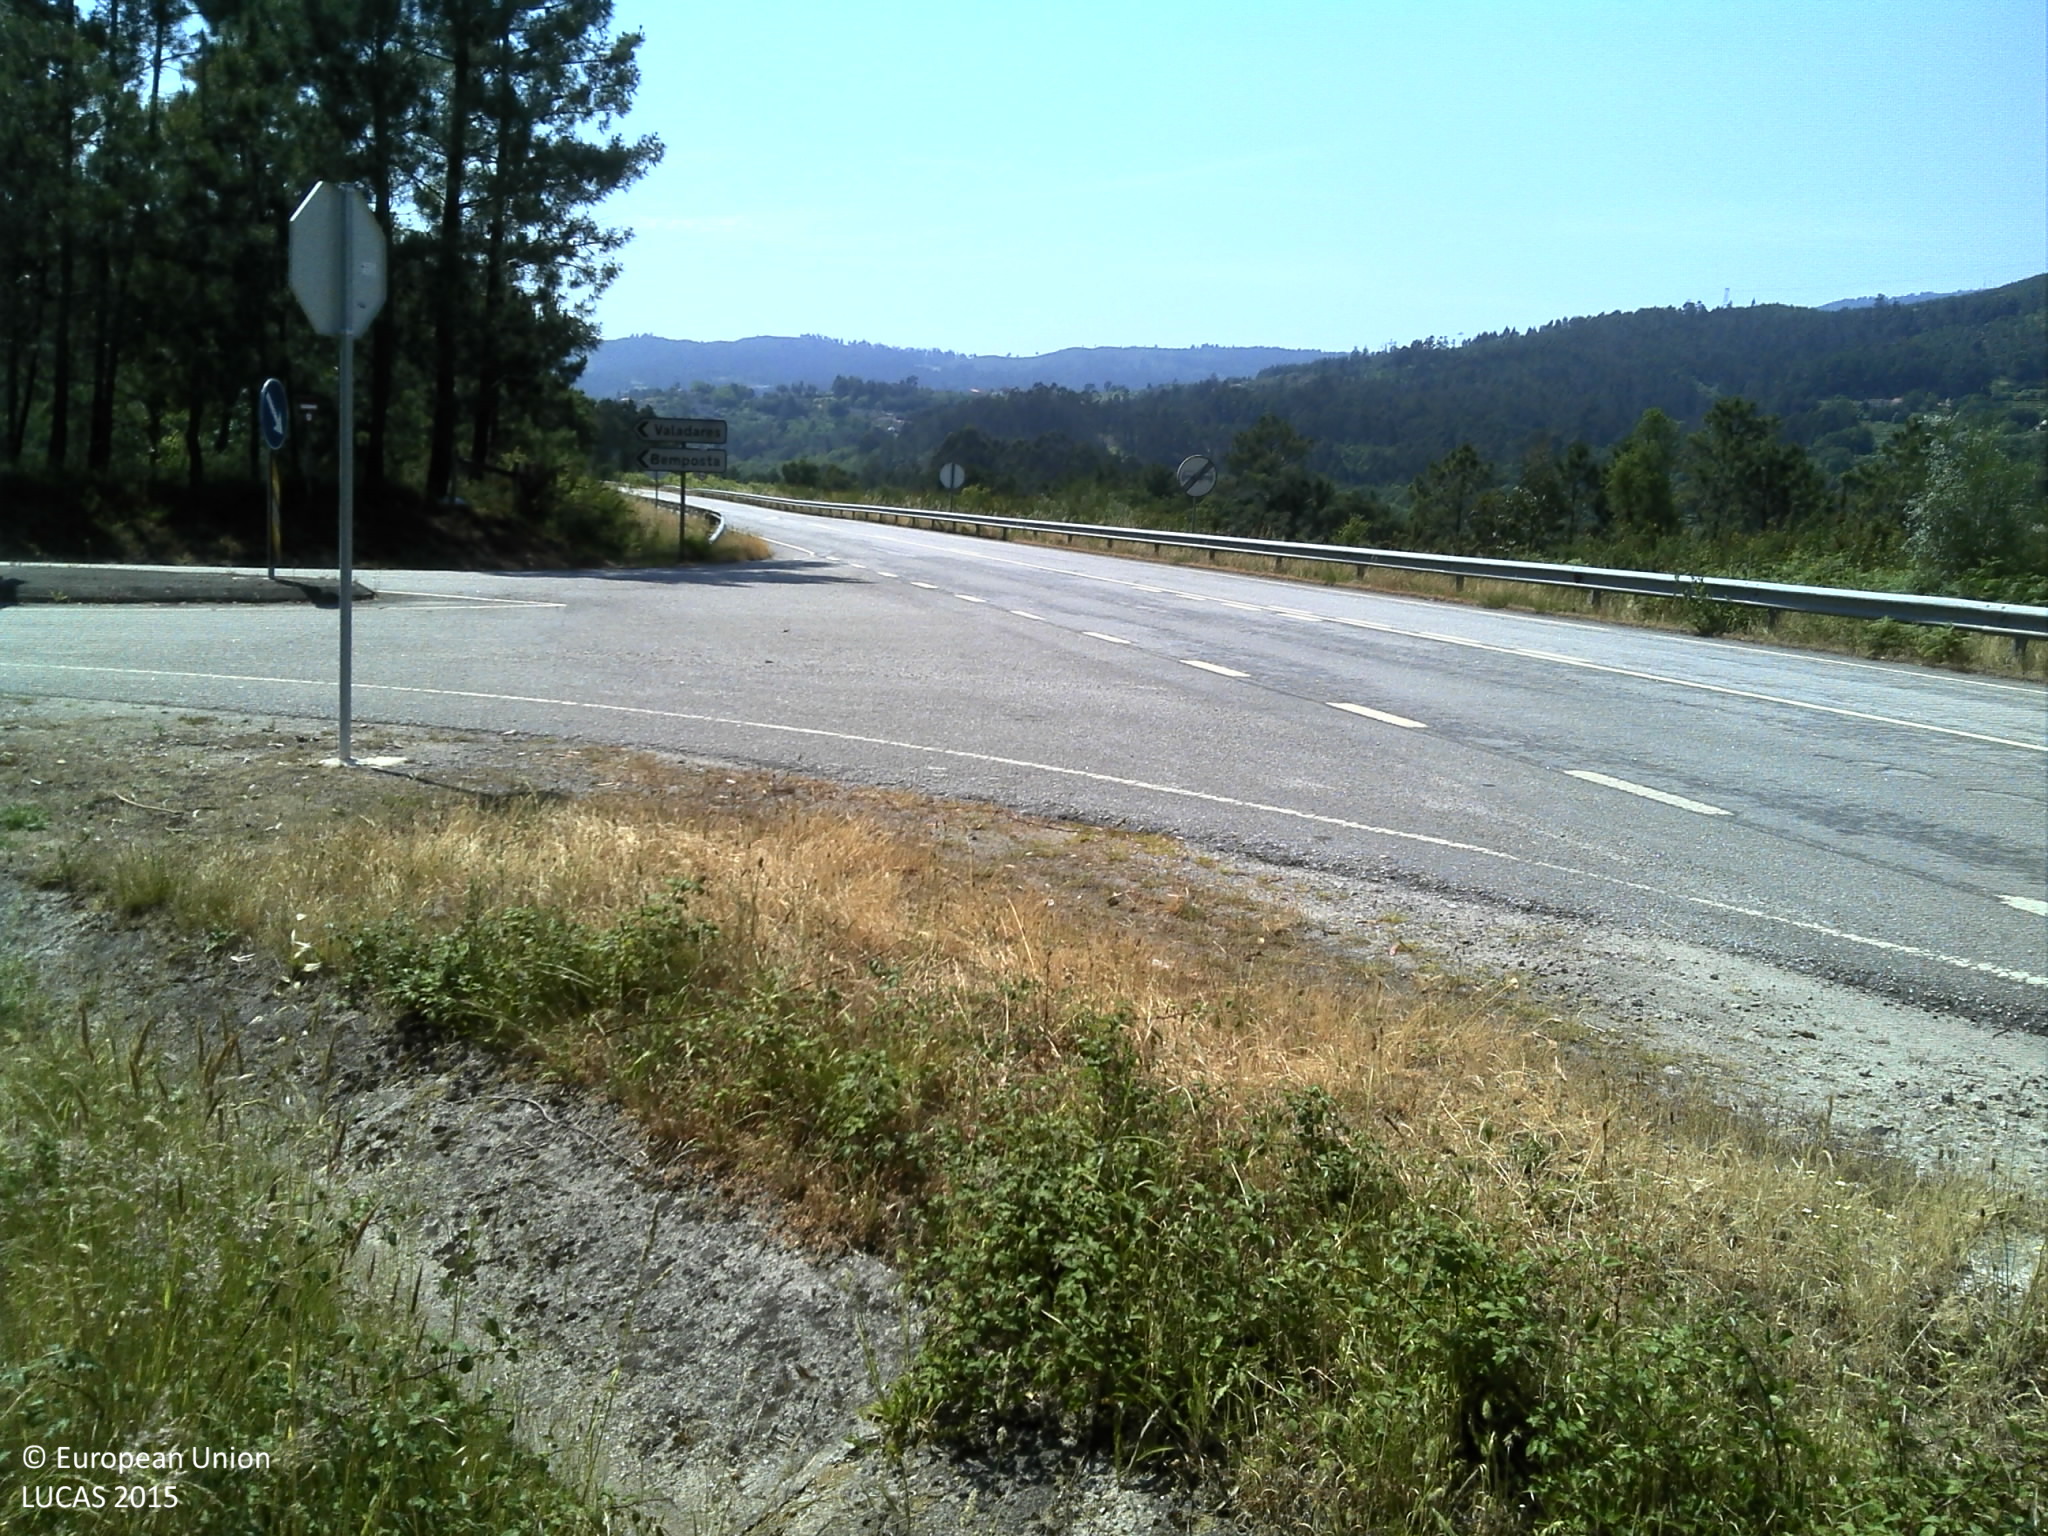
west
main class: Shrubland
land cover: Shrubland with sparse tree cover
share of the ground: > 75 %
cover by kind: shrubs 85 %, broadleaved forest trees 5 %, consolidated bare surface 5 %, unconsolidated bare surface 5 %
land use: Forestry
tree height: > 5 m
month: June
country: PT
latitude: 42.0865
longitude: -8.3546
